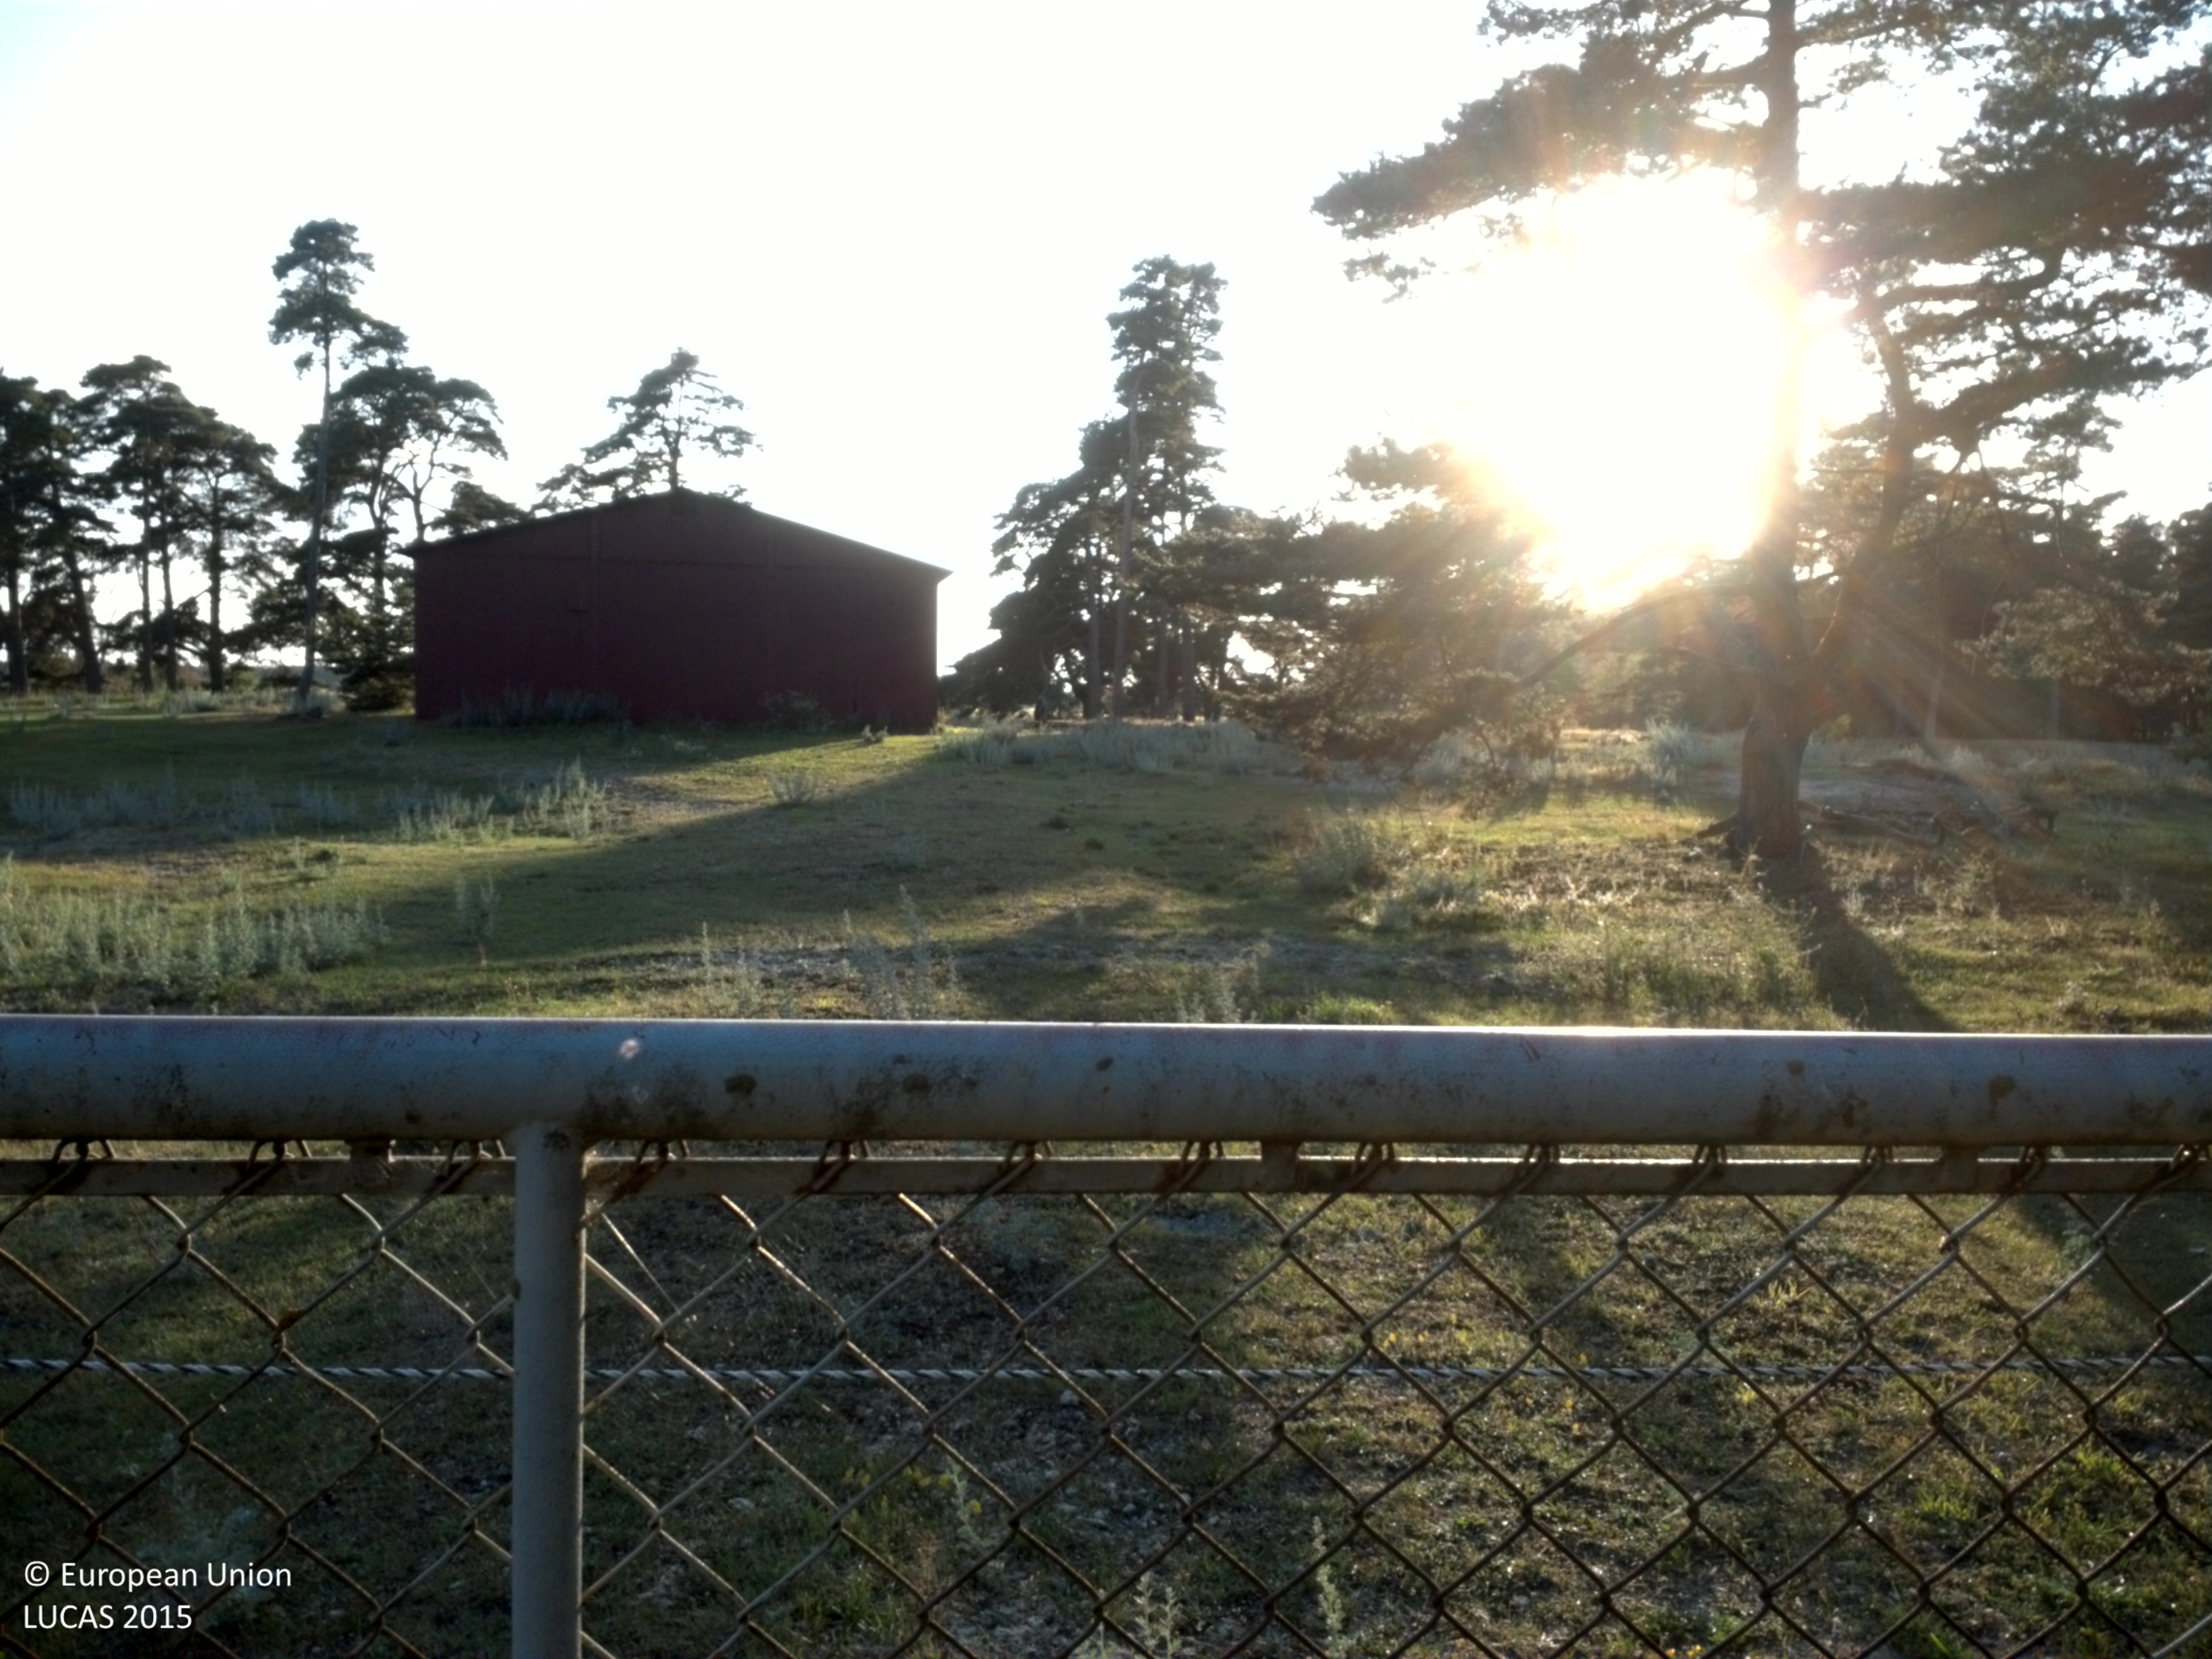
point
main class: Grassland
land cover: Grassland with sparse tree/shrub cover
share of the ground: > 75 %
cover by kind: herbaceous plants 90 %, coniferous forest trees 5 %, unconsolidated bare surface 5 %
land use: Agriculture (excluding fallow land and kitchen gardens)
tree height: > 5 m
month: July
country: SE
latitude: 57.2446
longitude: 18.2107
